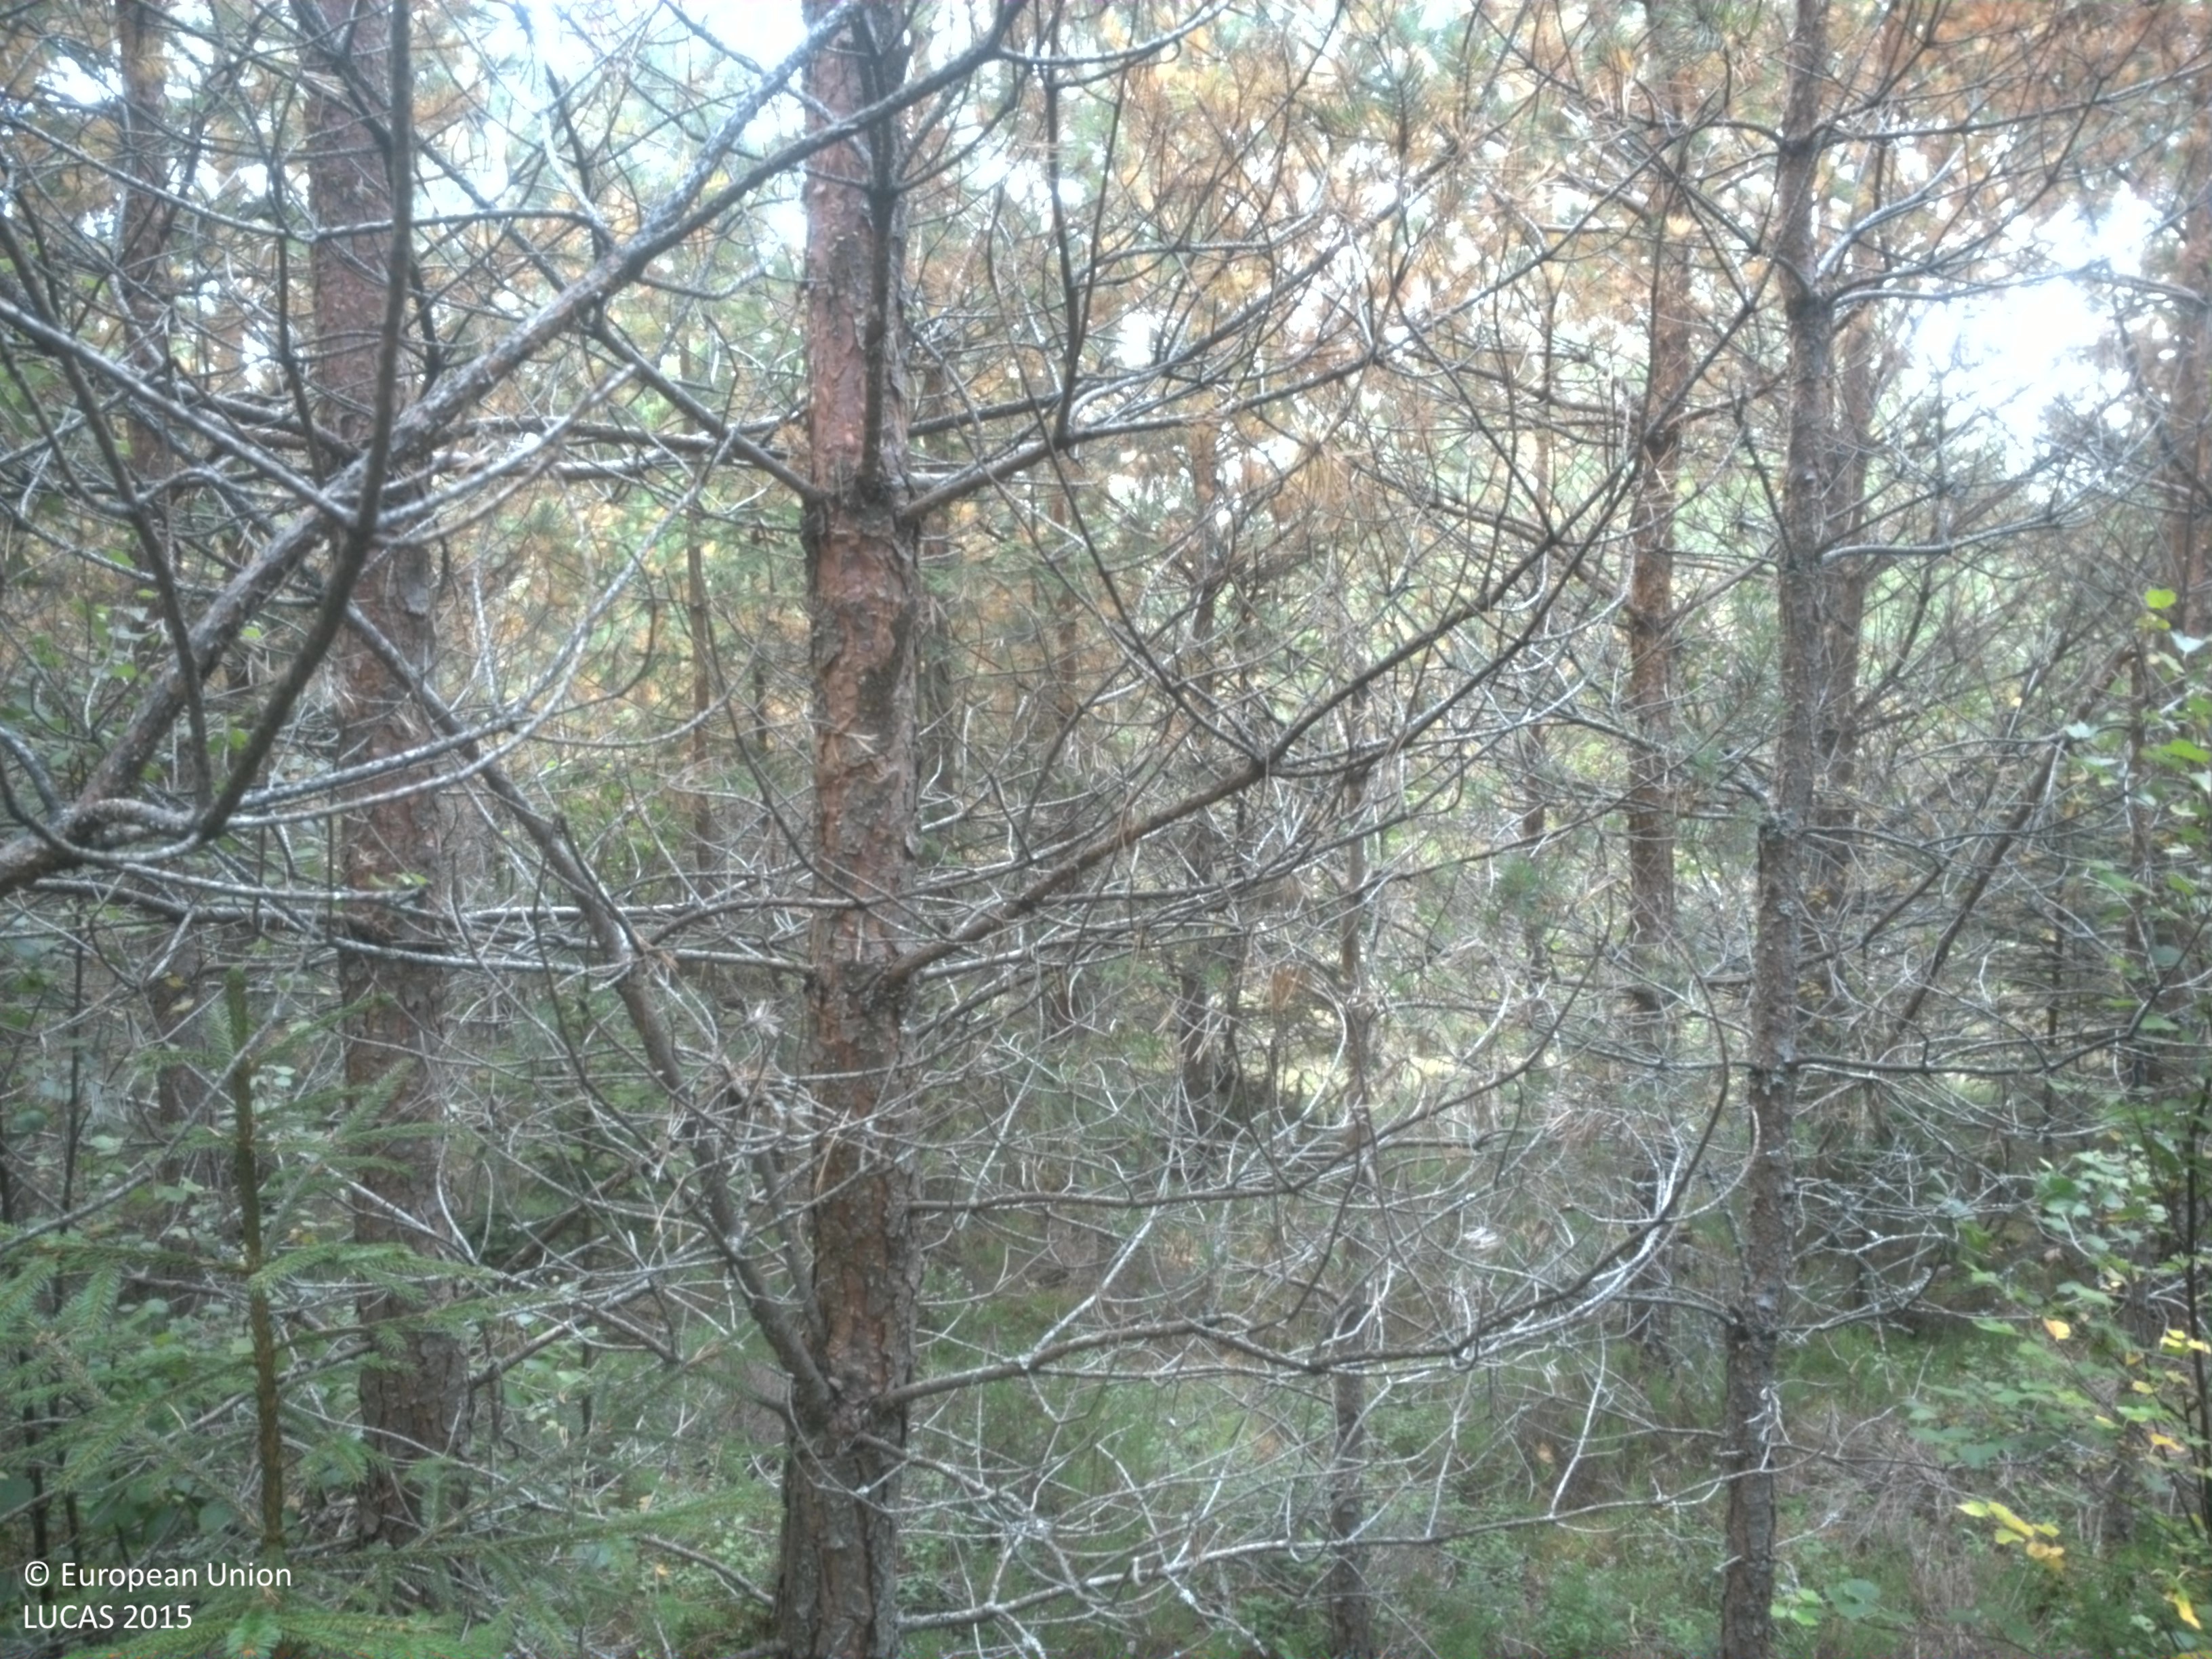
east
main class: Woodland
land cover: Pine dominated coniferous woodland
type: boreal forest
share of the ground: > 75 %
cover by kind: coniferous forest trees 80 %, shrubs 10 %, lichens and mosses 10 %
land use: Forestry
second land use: Amenities, museums, leisure
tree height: > 5 m
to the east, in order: Pine dominated coniferous woodland; Inland marshes; Pine dominated coniferous woodland
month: September
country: SE
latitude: 59.7269
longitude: 15.5923
